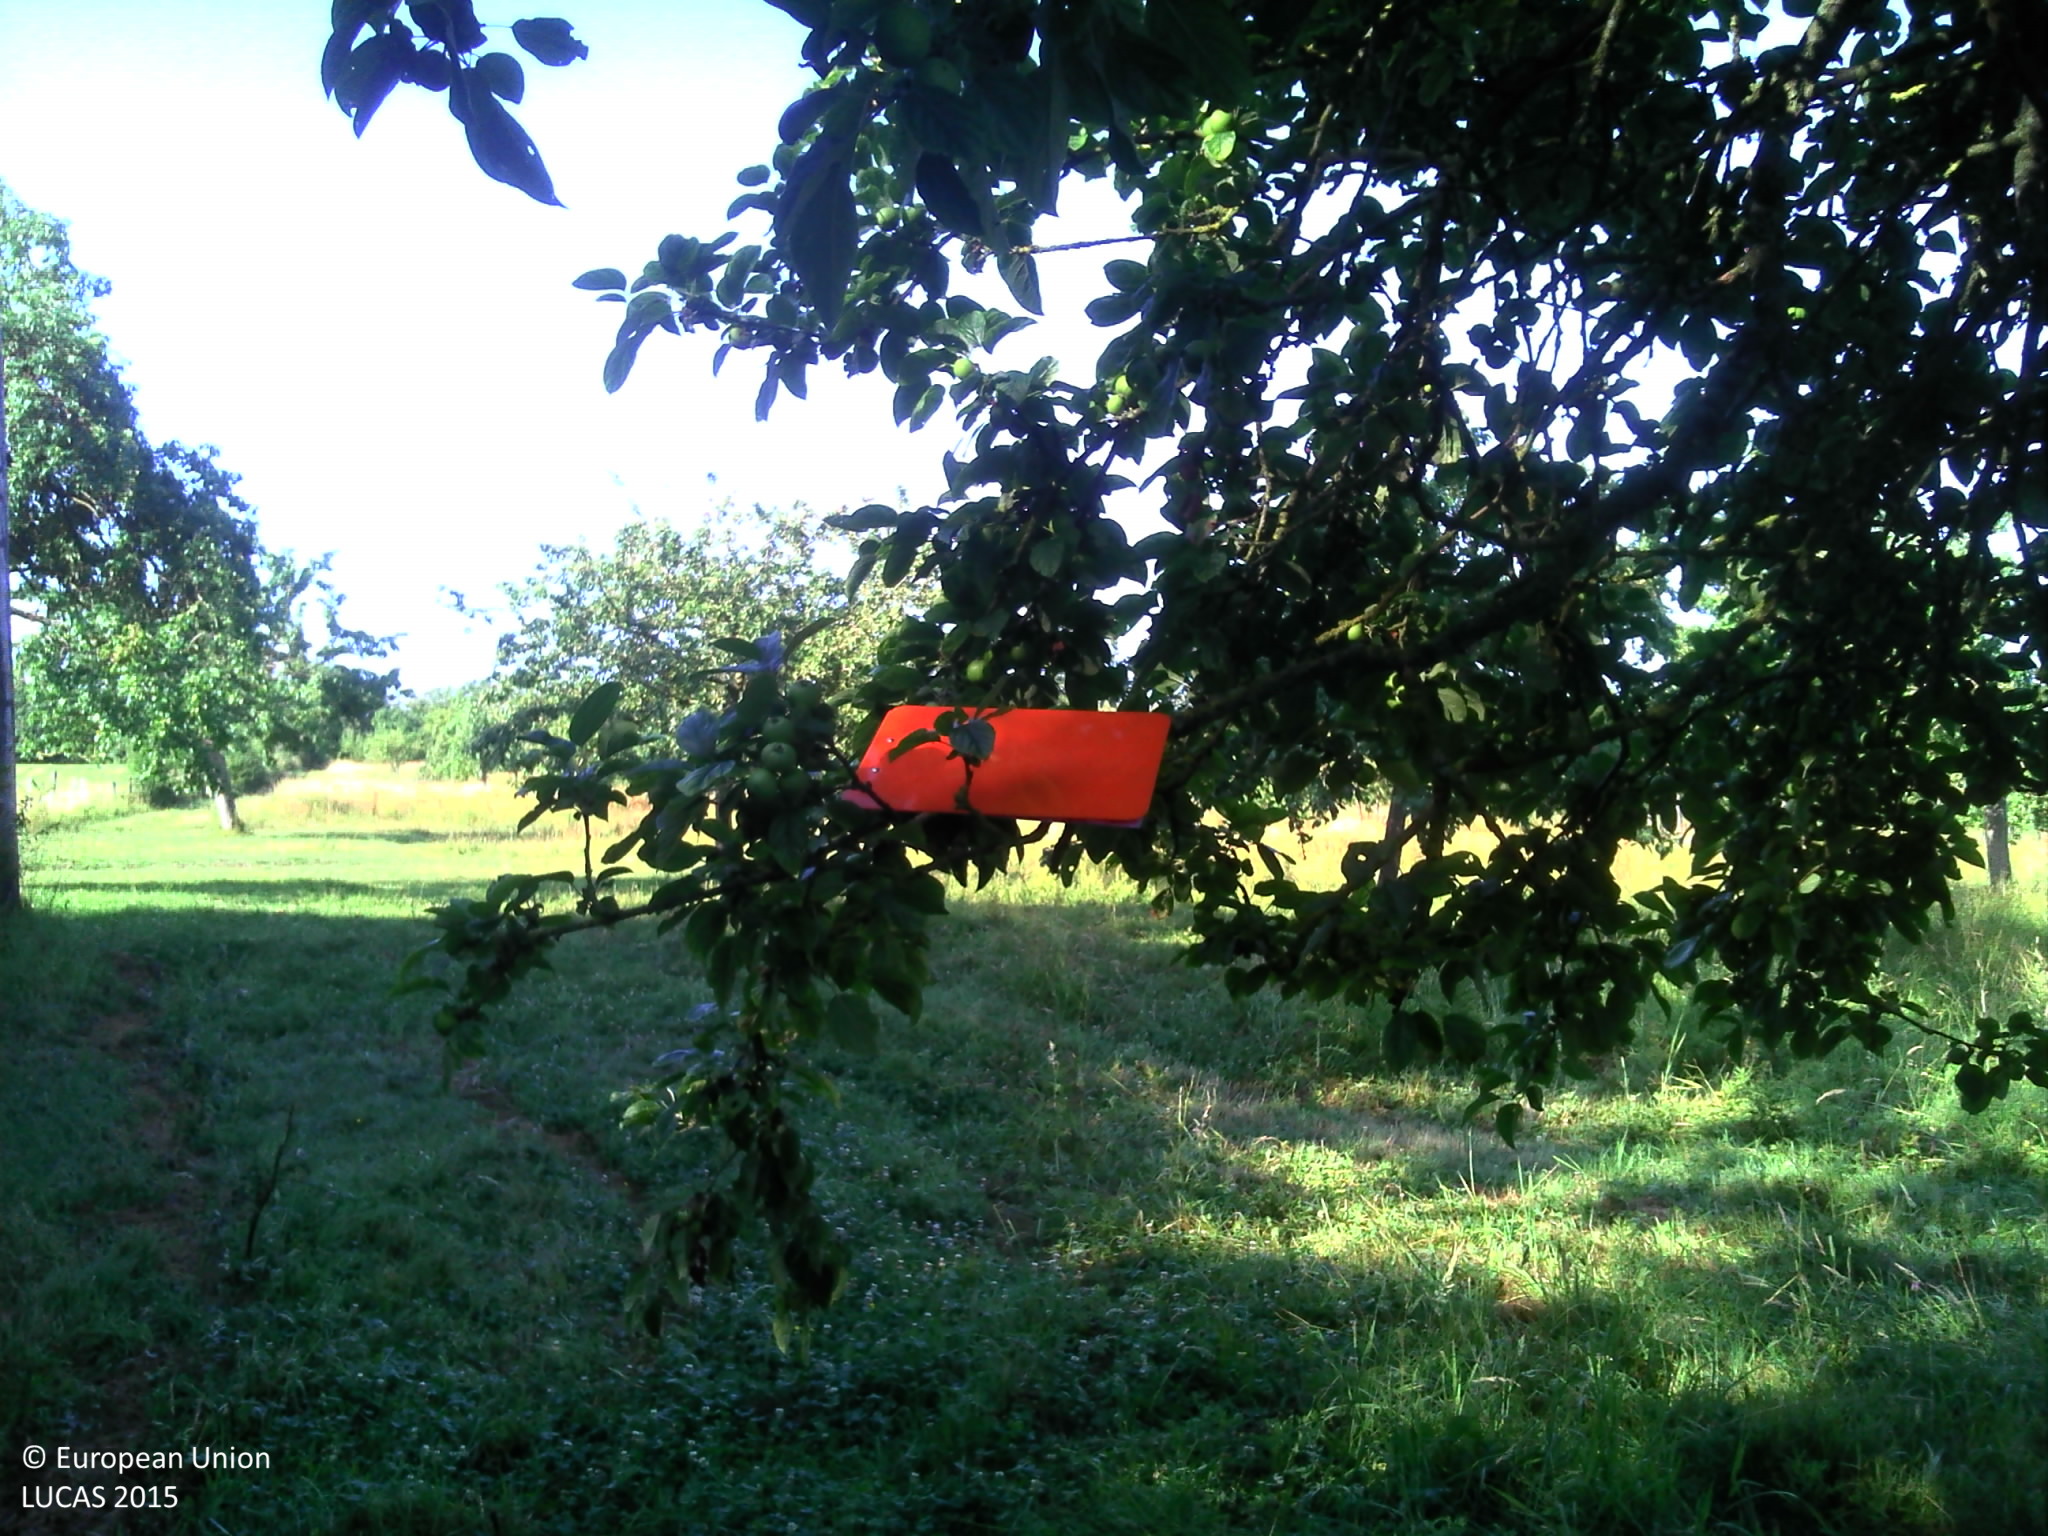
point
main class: Cropland
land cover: Apple fruit
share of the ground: 10 - 25 %
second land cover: Grassland without tree/shrub cover
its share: > 75 %
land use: Agriculture (excluding fallow land and kitchen gardens)
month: July
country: FR
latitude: 49.0365
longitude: -0.0027
